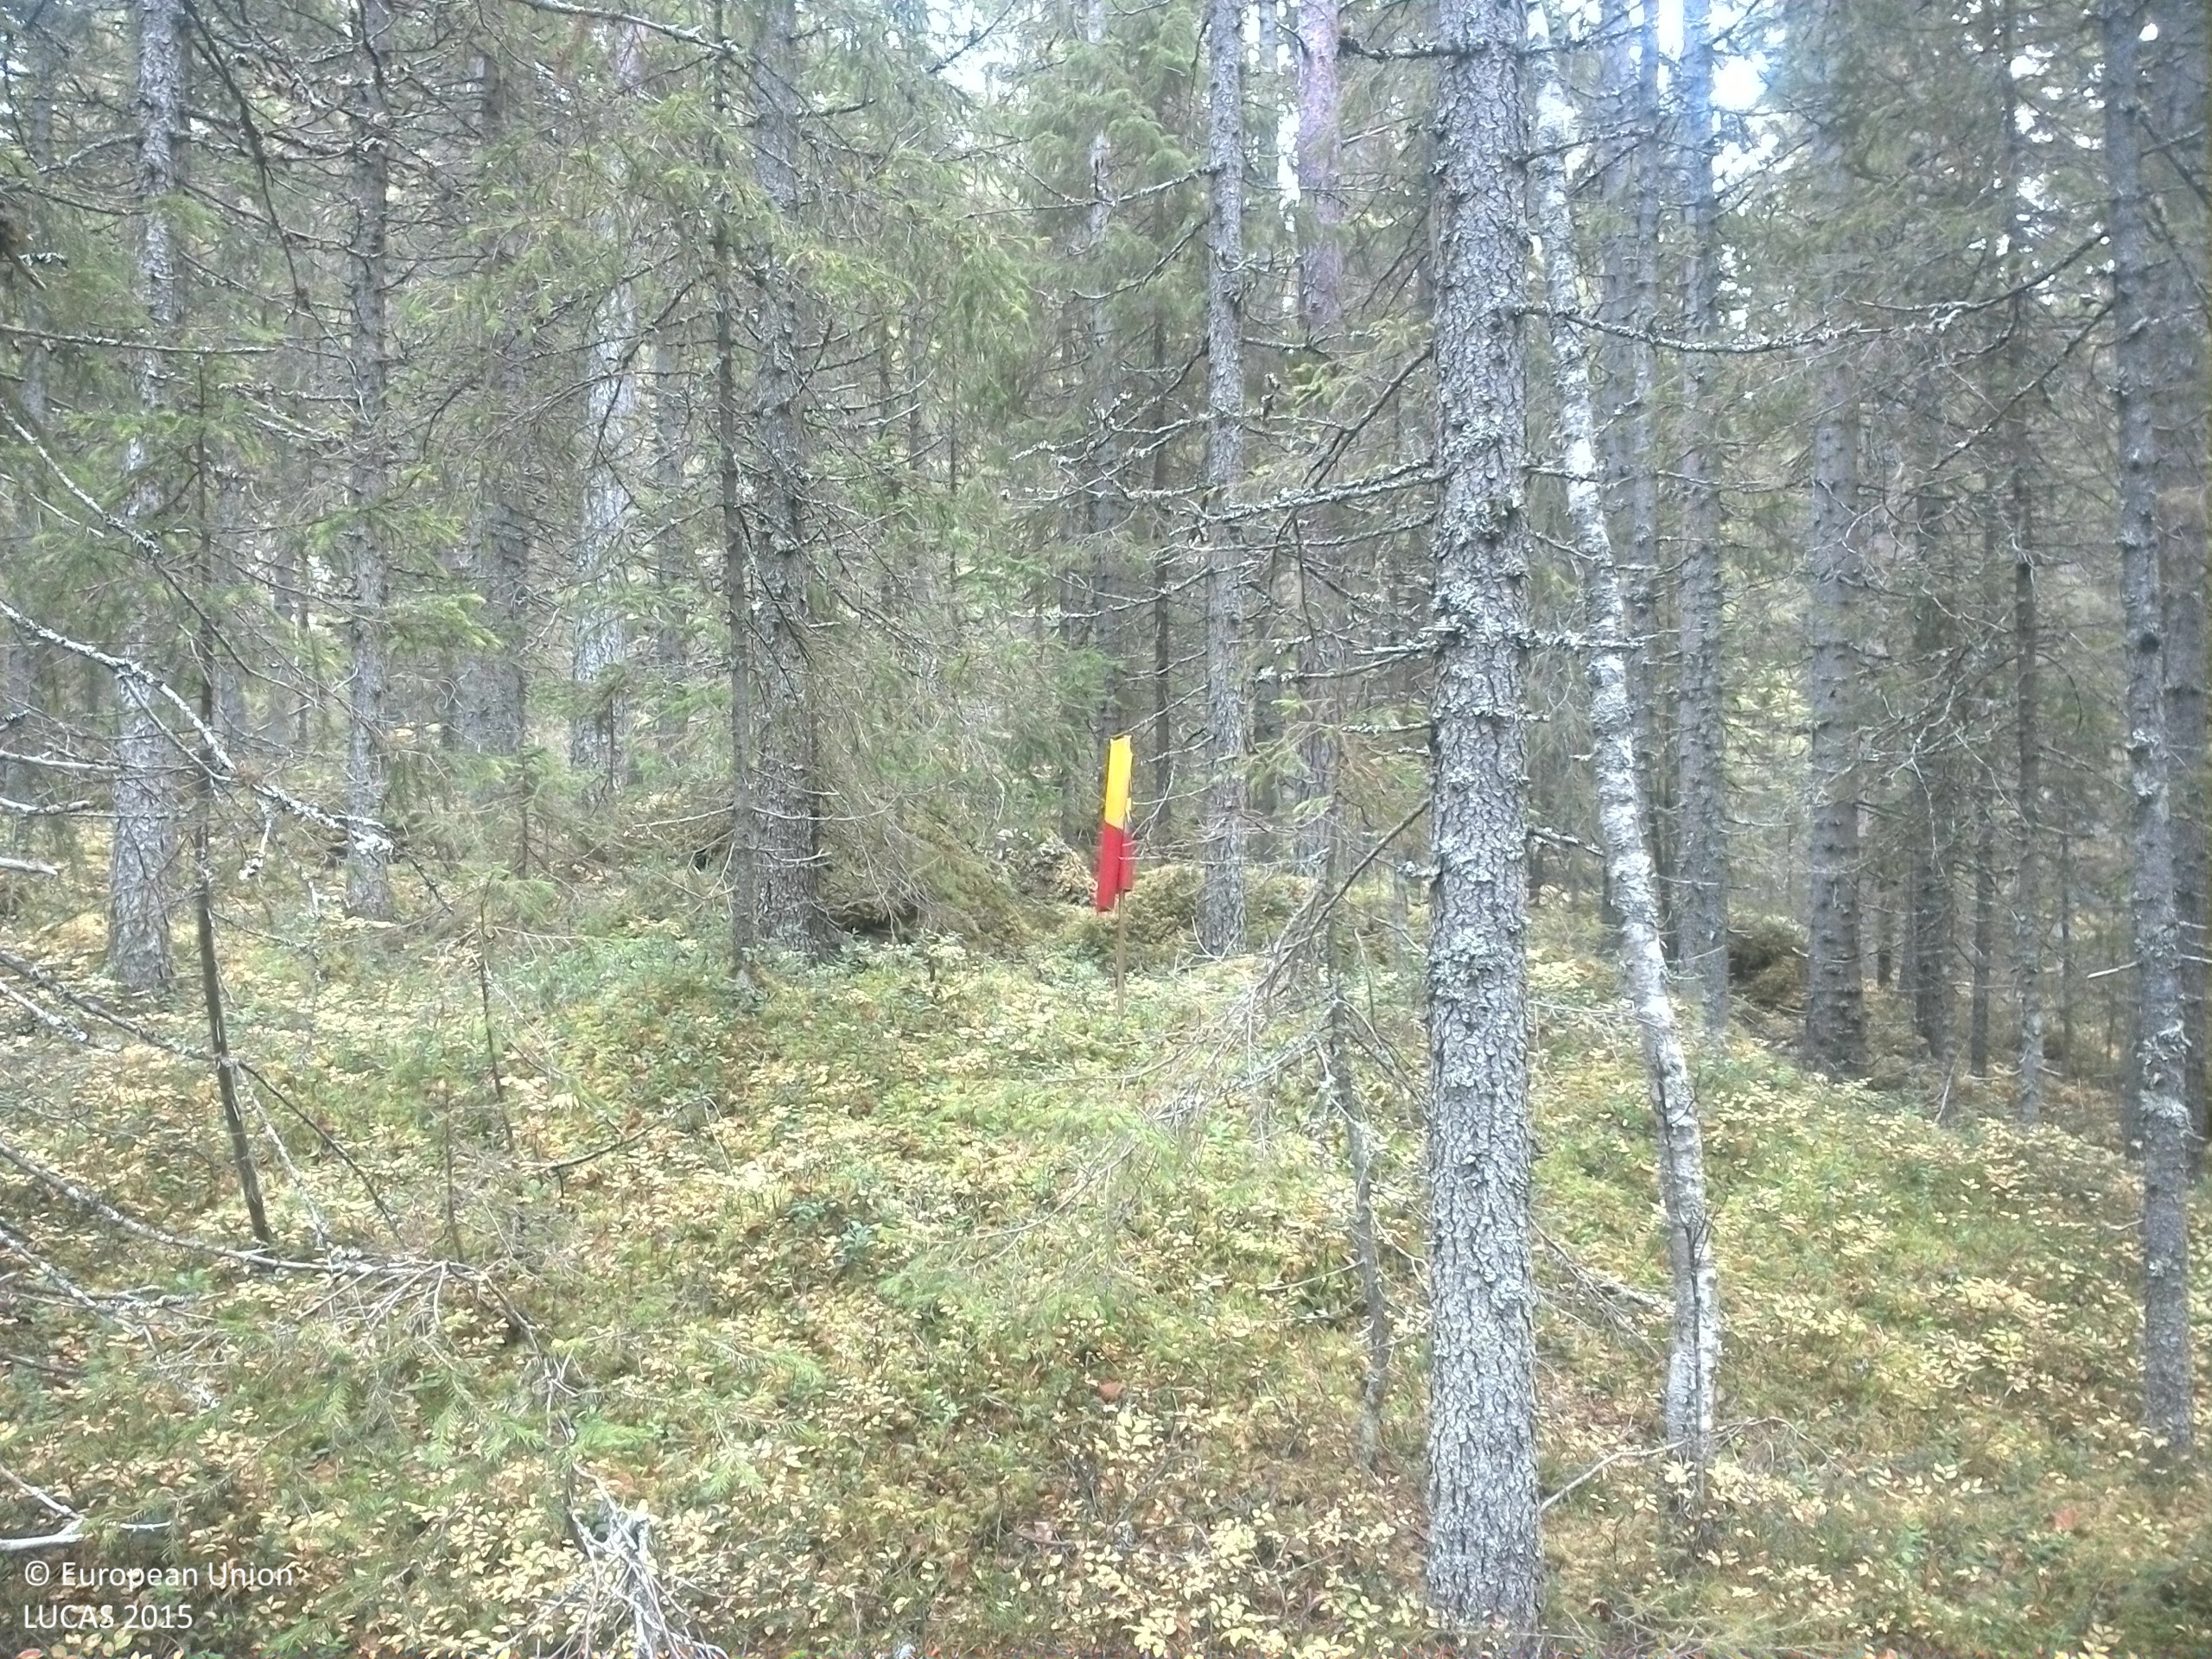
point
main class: Woodland
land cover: Spruce dominated coniferous woodland
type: boreal forest
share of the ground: 50 - 75 %
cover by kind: coniferous forest trees 65 %, shrubs 20 %, lichens and mosses 15 %
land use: Forestry
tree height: > 5 m
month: October
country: SE
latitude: 64.3424
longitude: 14.8375
